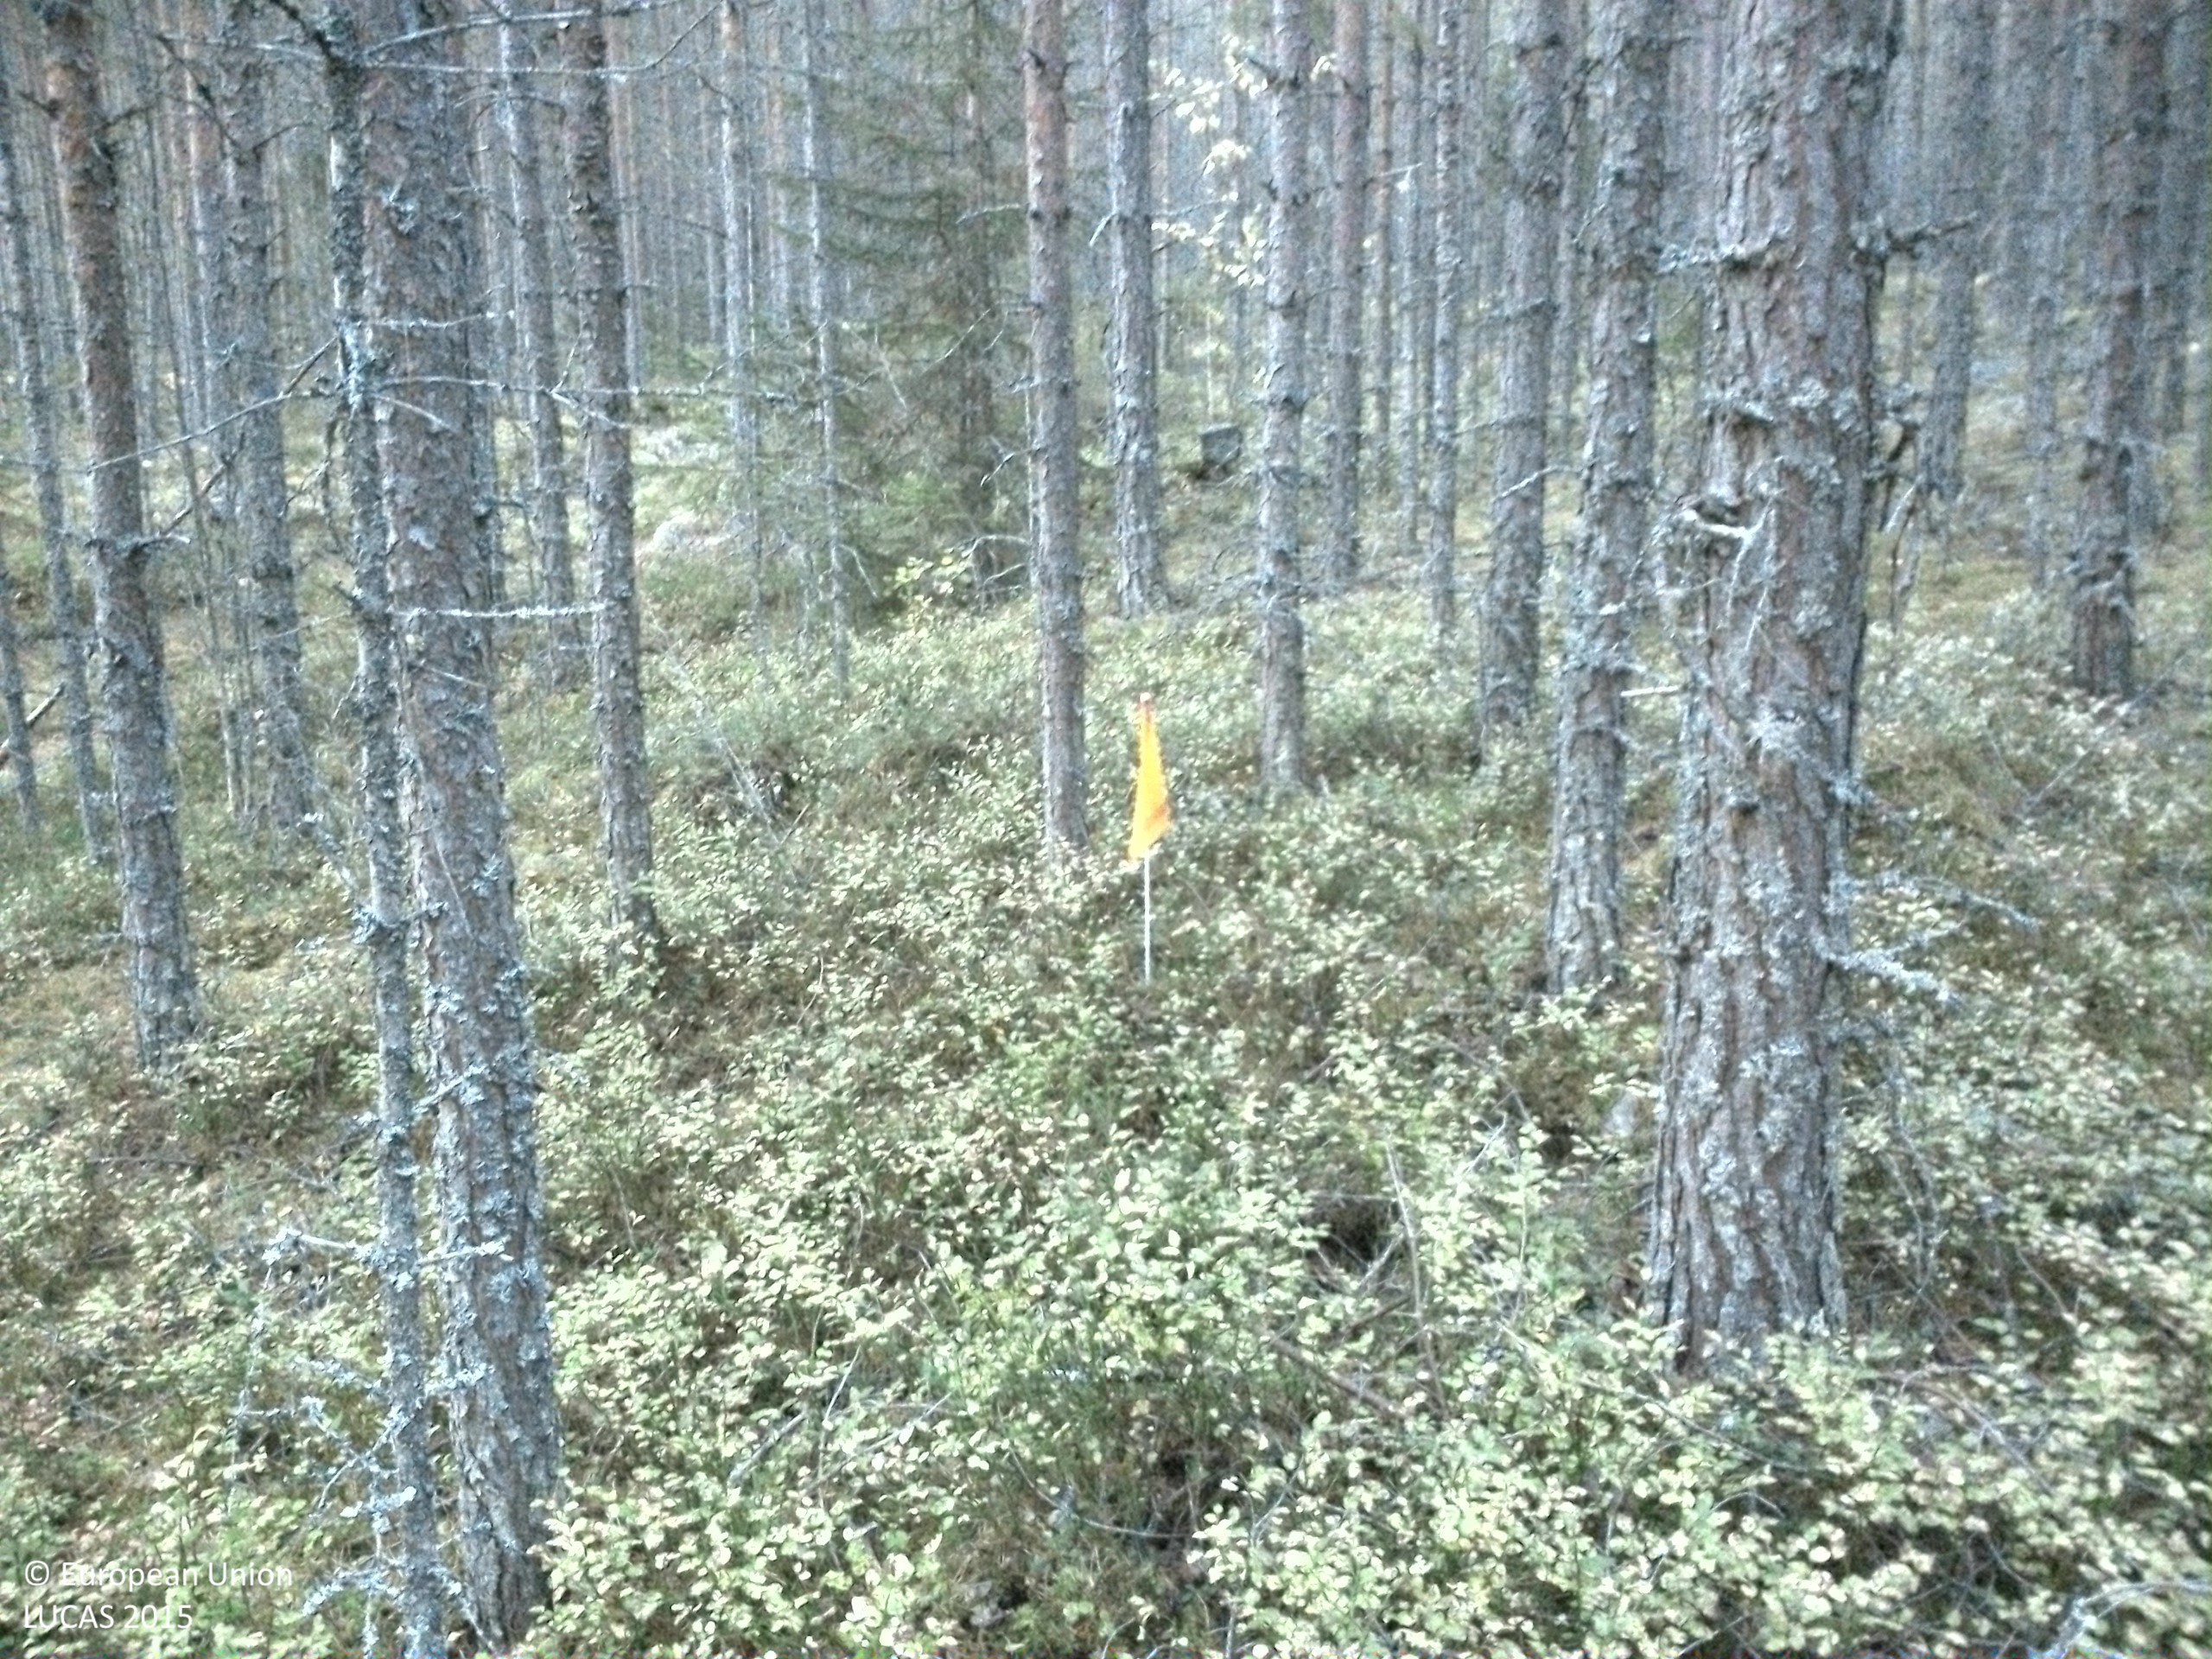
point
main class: Woodland
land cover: Pine dominated coniferous woodland
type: boreal forest
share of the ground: > 75 %
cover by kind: coniferous forest trees 75 %, shrubs 25 %
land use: Forestry
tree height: > 5 m
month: October
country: SE
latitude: 61.2086
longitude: 15.0667
